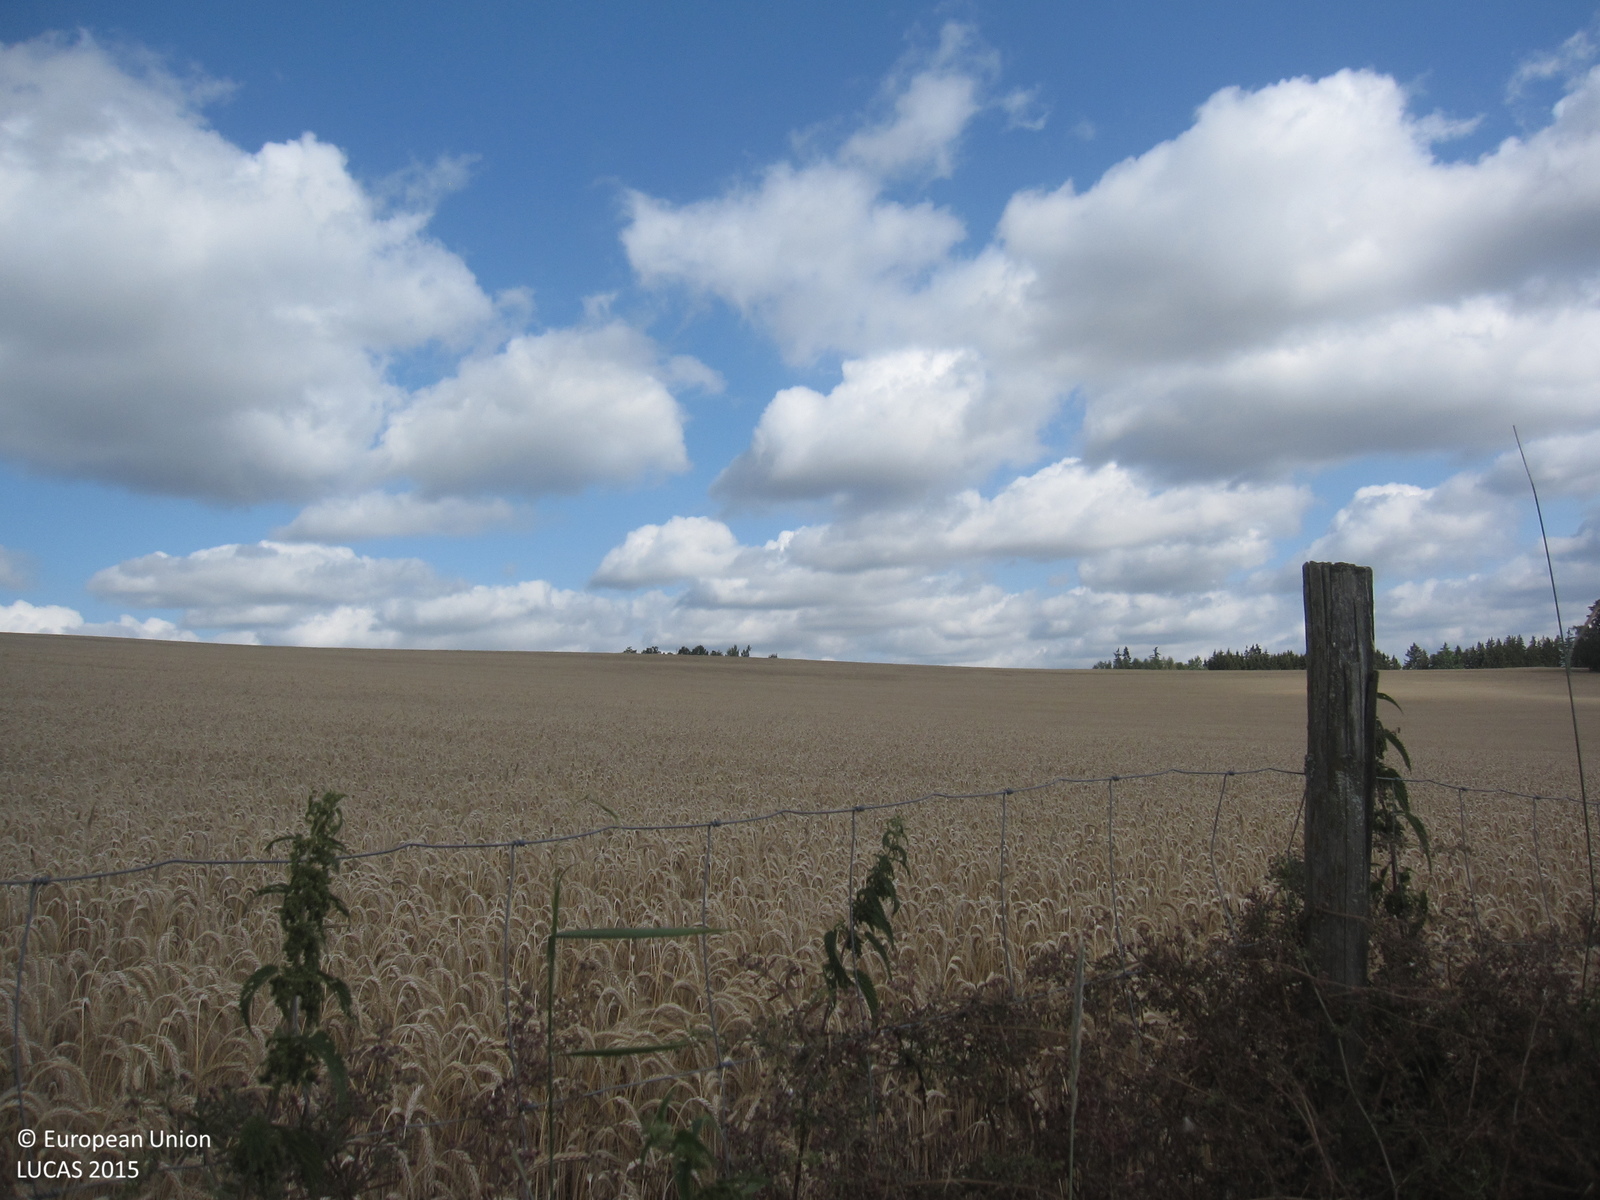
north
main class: Cropland
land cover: Rye
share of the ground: > 75 %
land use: Agriculture (excluding fallow land and kitchen gardens)
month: July
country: DE
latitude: 50.3819
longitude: 12.0388
